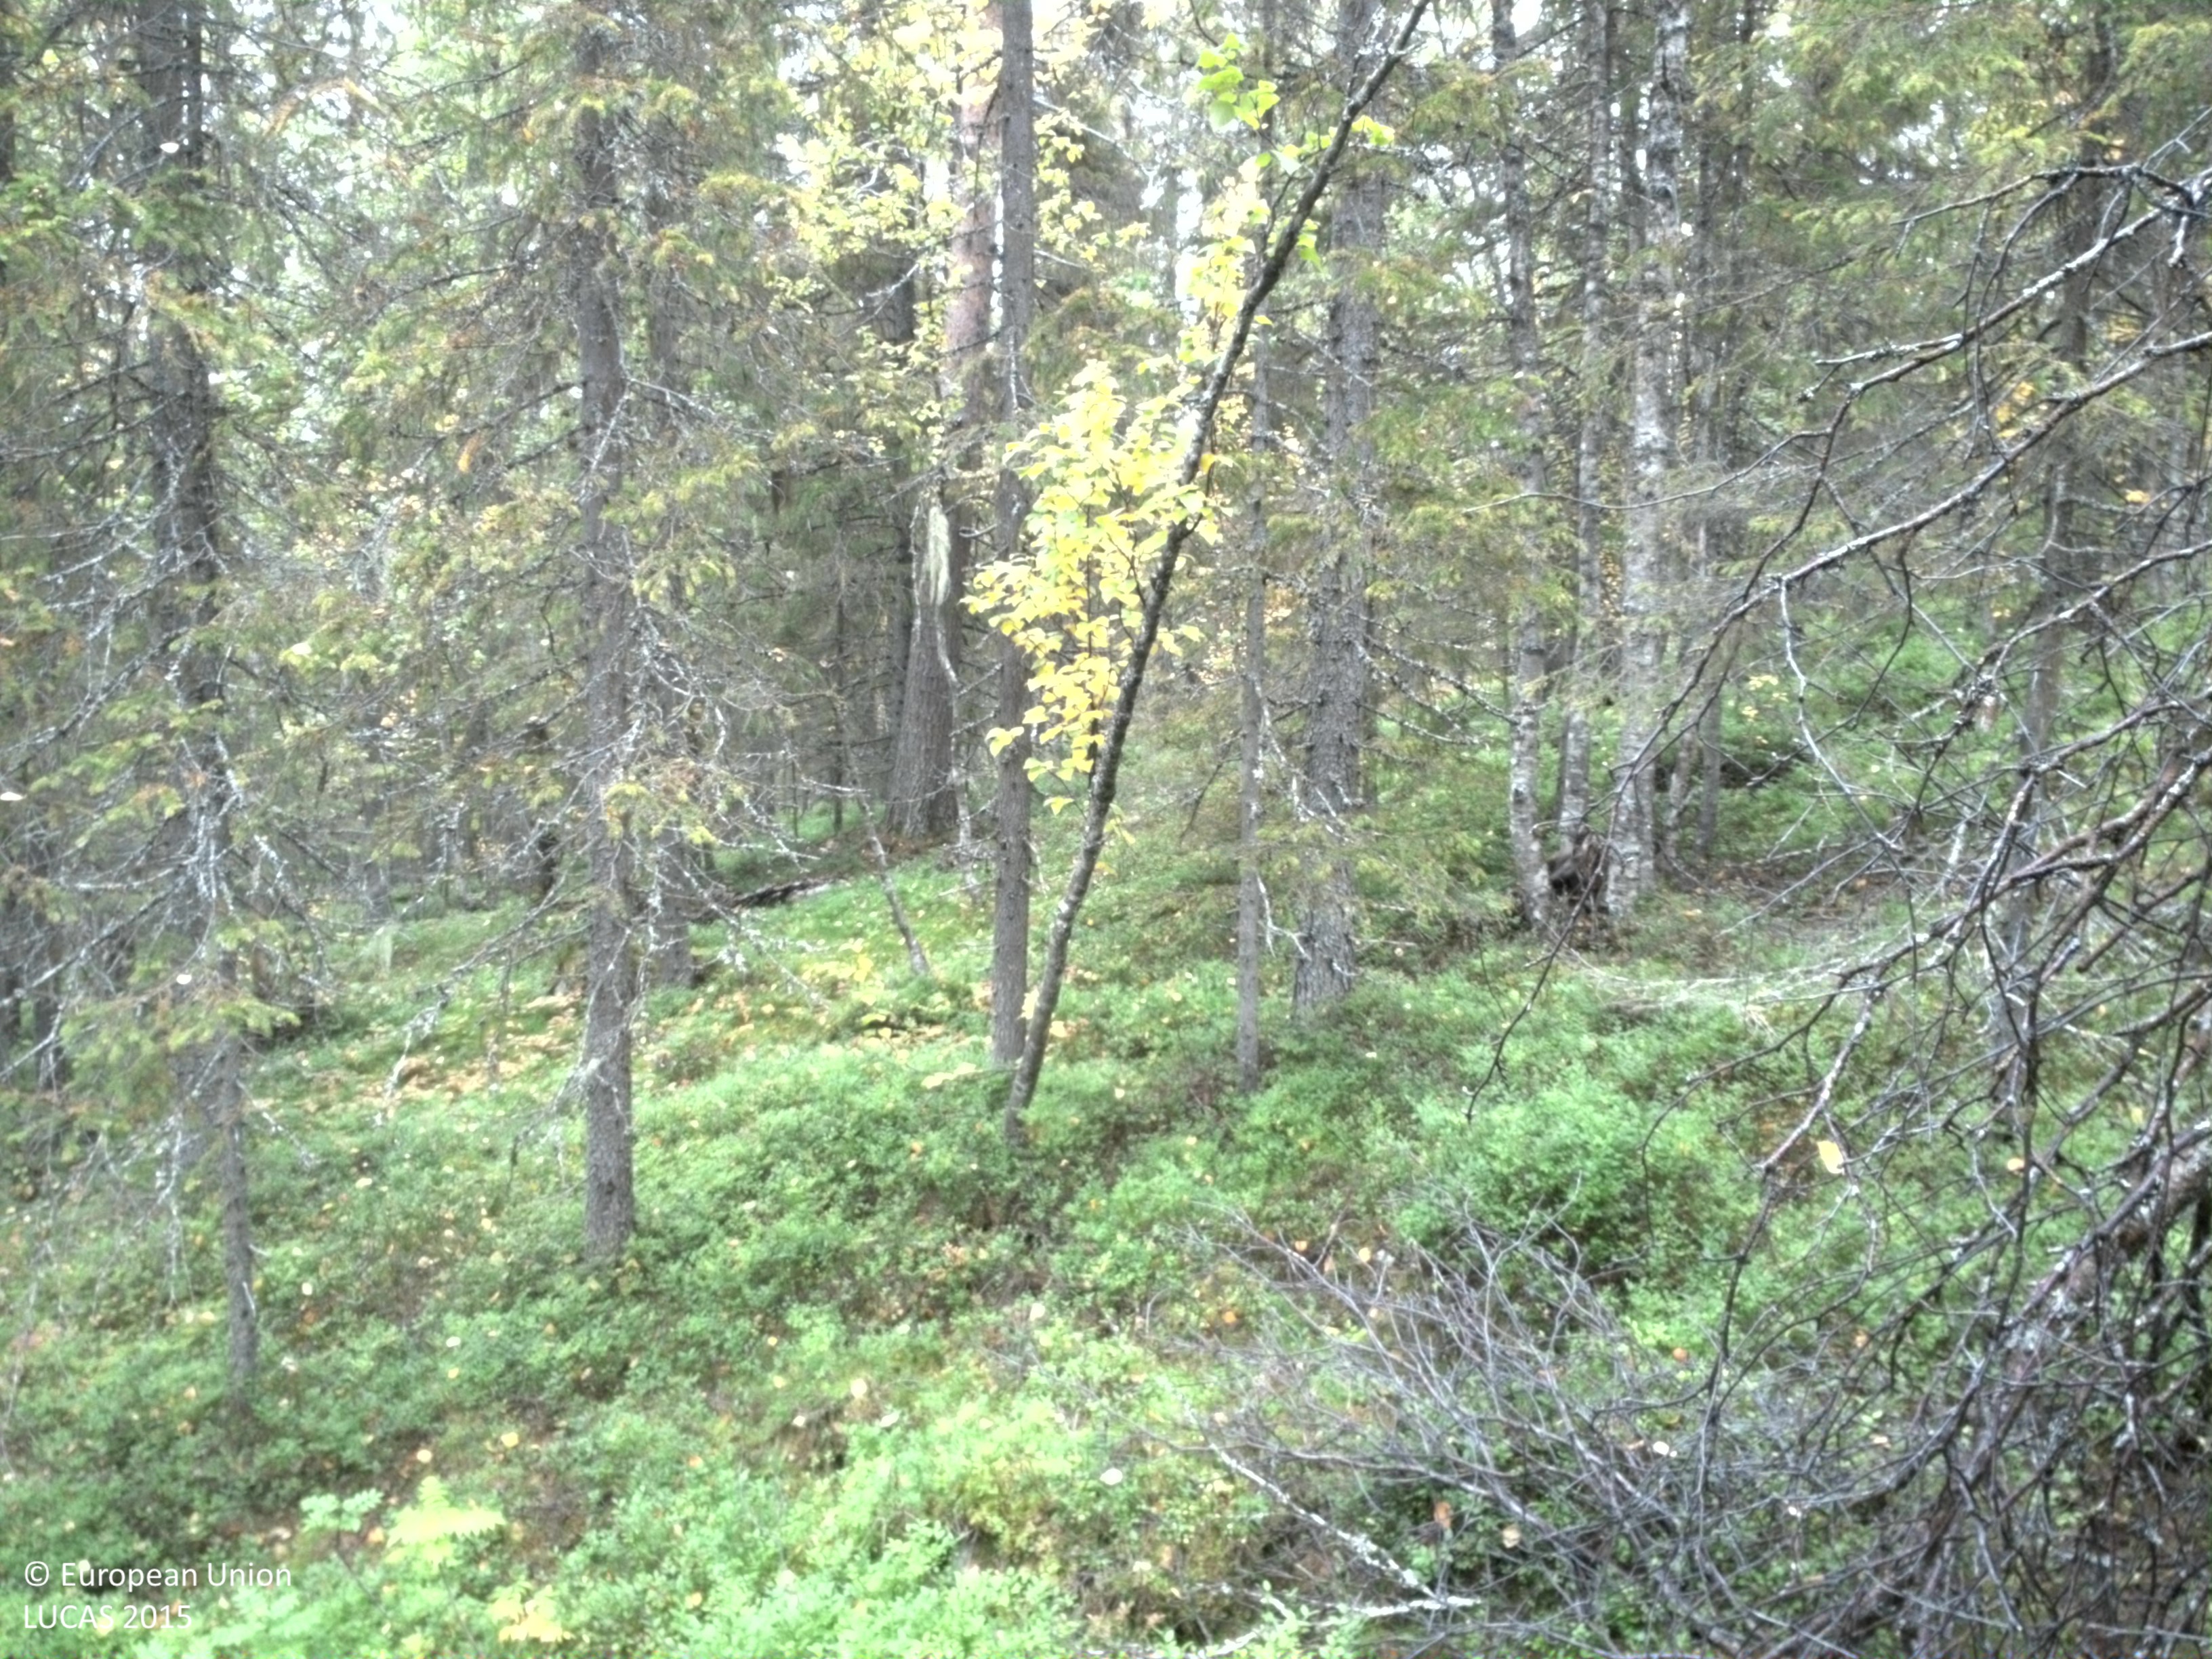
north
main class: Woodland
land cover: Spruce dominated mixed woodland
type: boreal forest
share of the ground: 25 - 50 %
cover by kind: shrubs 40 %, coniferous forest trees 25 %, lichens and mosses 15 %, broadleaved forest trees 10 %, herbaceous plants 10 %
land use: Forestry
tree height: > 5 m
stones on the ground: 10 - 25 %
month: September
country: SE
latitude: 65.1589
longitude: 16.8111
